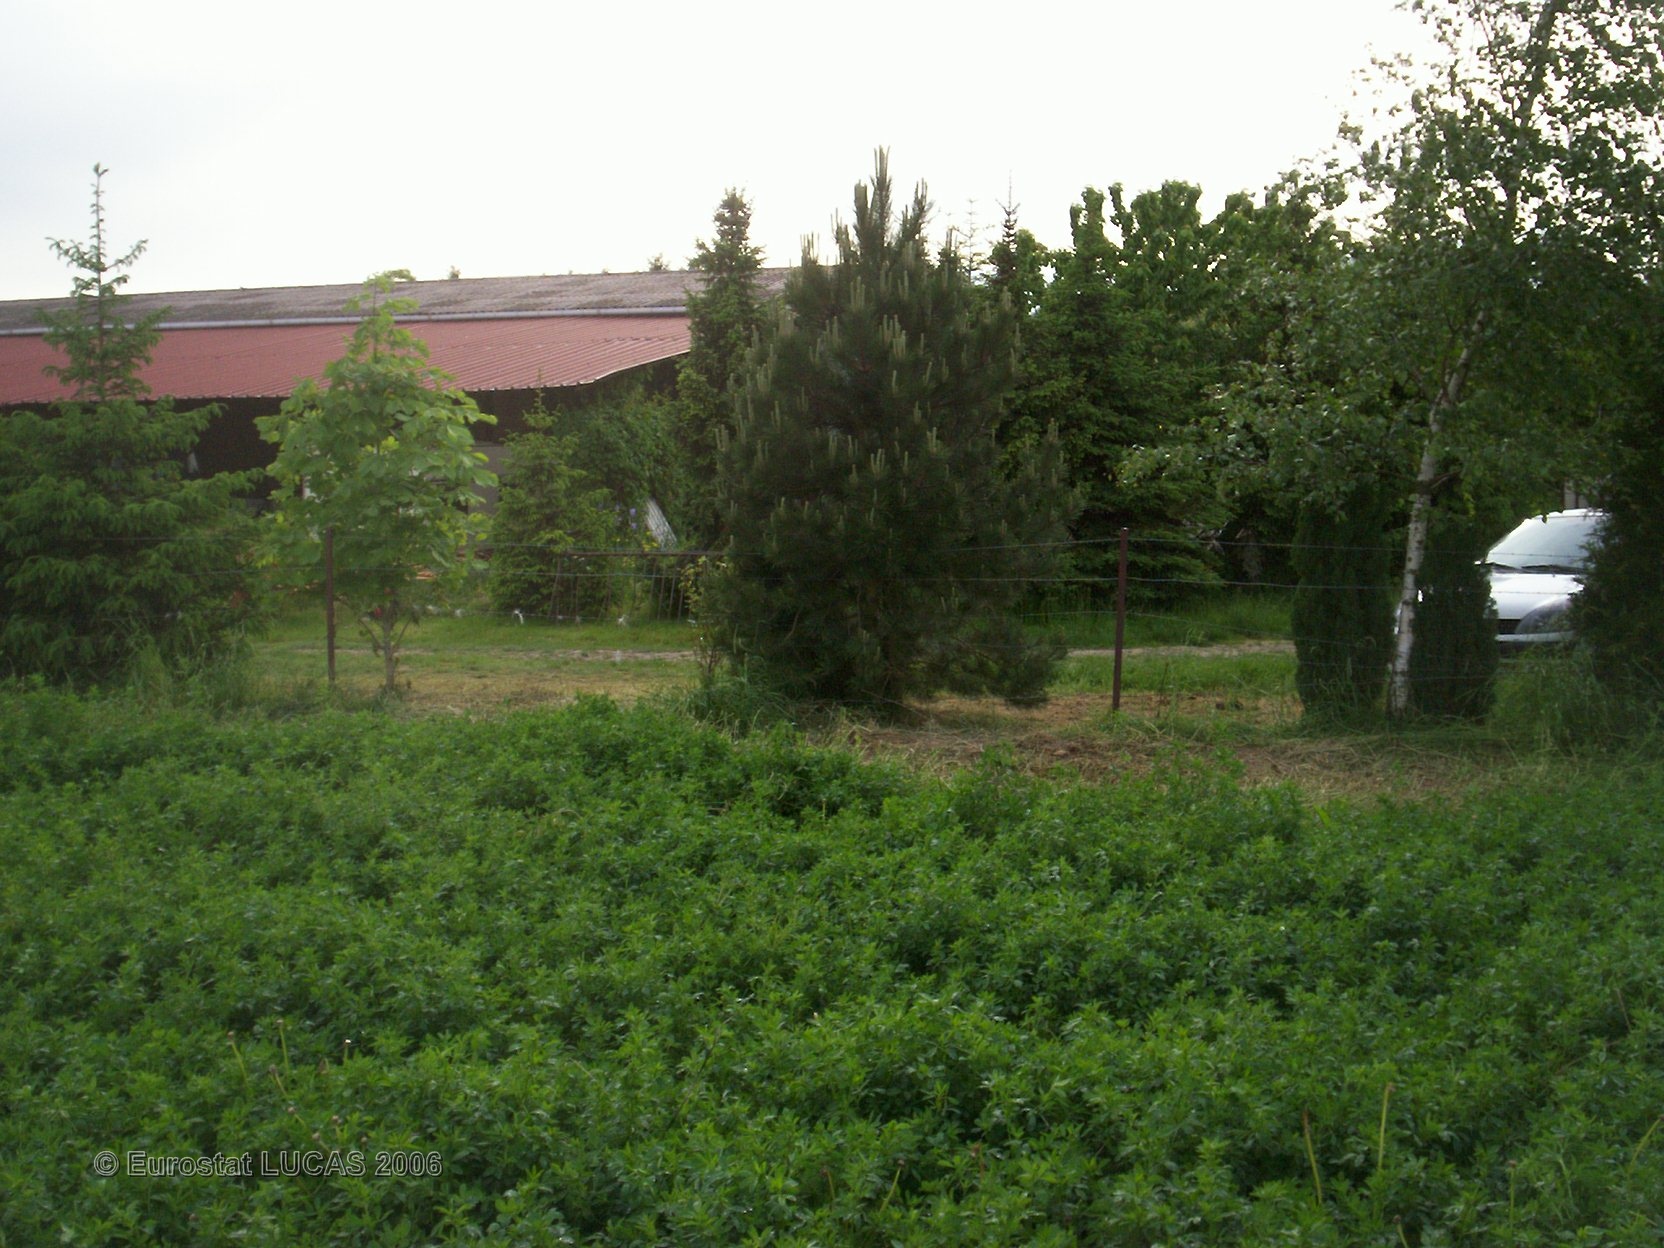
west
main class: Cropland
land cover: Lucerne
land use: Agriculture (excluding fallow land and kitchen gardens)
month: May
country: FR
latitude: 49.4495
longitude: 4.3542
